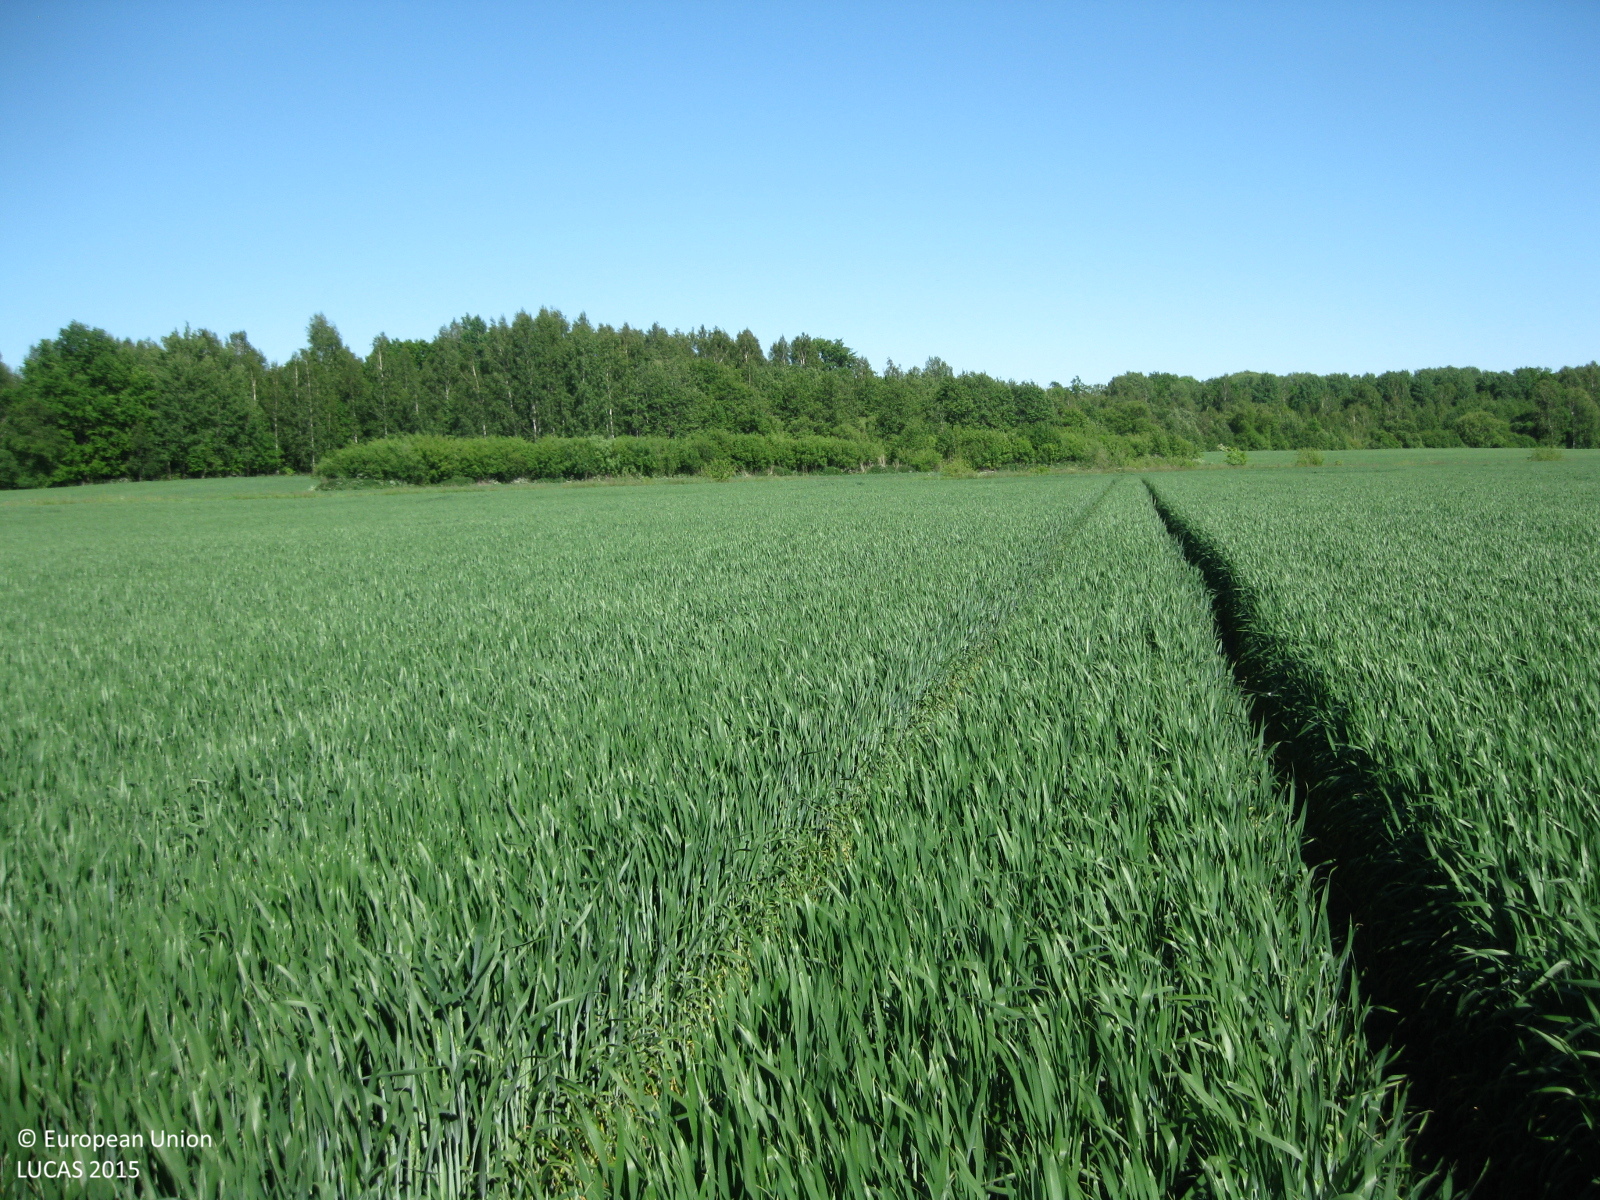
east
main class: Cropland
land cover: Common wheat
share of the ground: > 75 %
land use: Agriculture (excluding fallow land and kitchen gardens)
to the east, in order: Common wheat; Grassland with sparse tree/shrub cover; Inland fresh running water; Common wheat; Spontaneously vegetated surfaces; Shrubland without tree cover; Broadleaved woodland
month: June
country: LT
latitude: 55.7025
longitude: 24.0447
